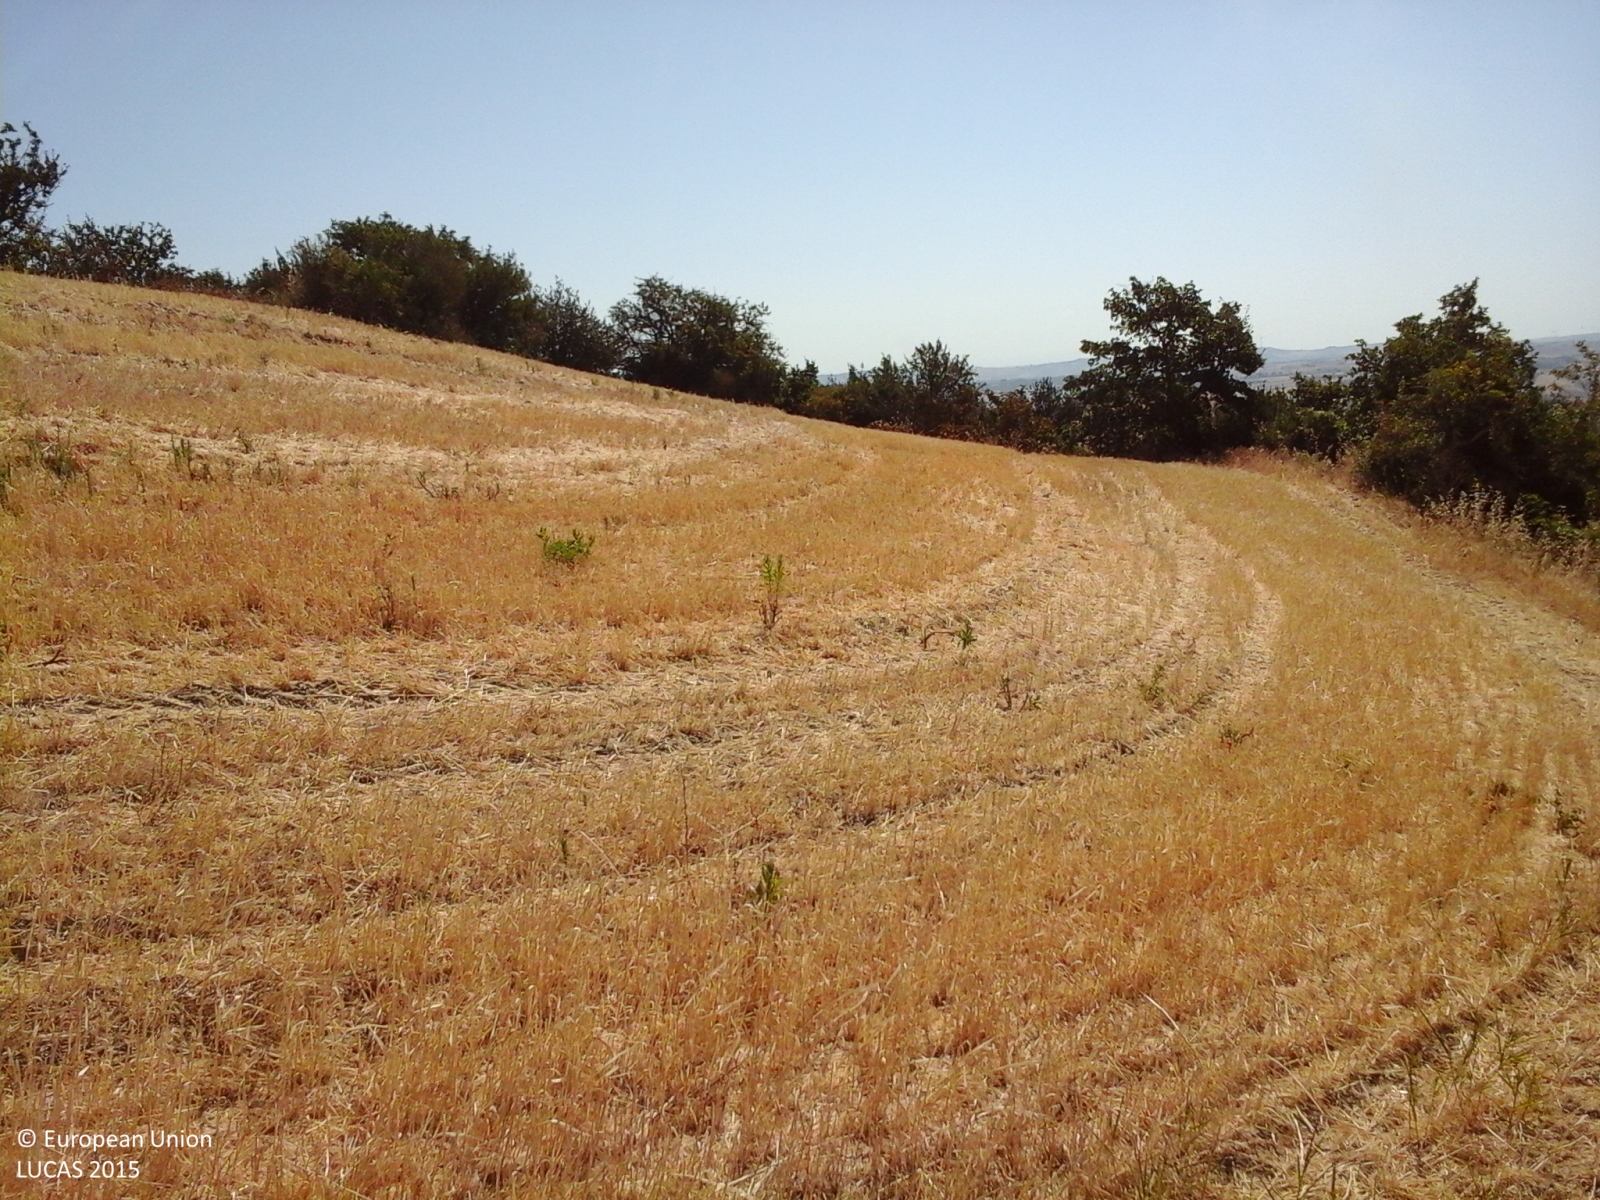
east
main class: Shrubland
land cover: Shrubland with sparse tree cover
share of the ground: > 75 %
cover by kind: shrubs 95 %, broadleaved forest trees 5 %
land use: Semi-natural and natural areas not in use
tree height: < 5 m
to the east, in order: Shrubland with sparse tree cover; Barley; Broadleaved woodland; Barley
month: July
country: IT
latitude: 41.8688
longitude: 14.8399
